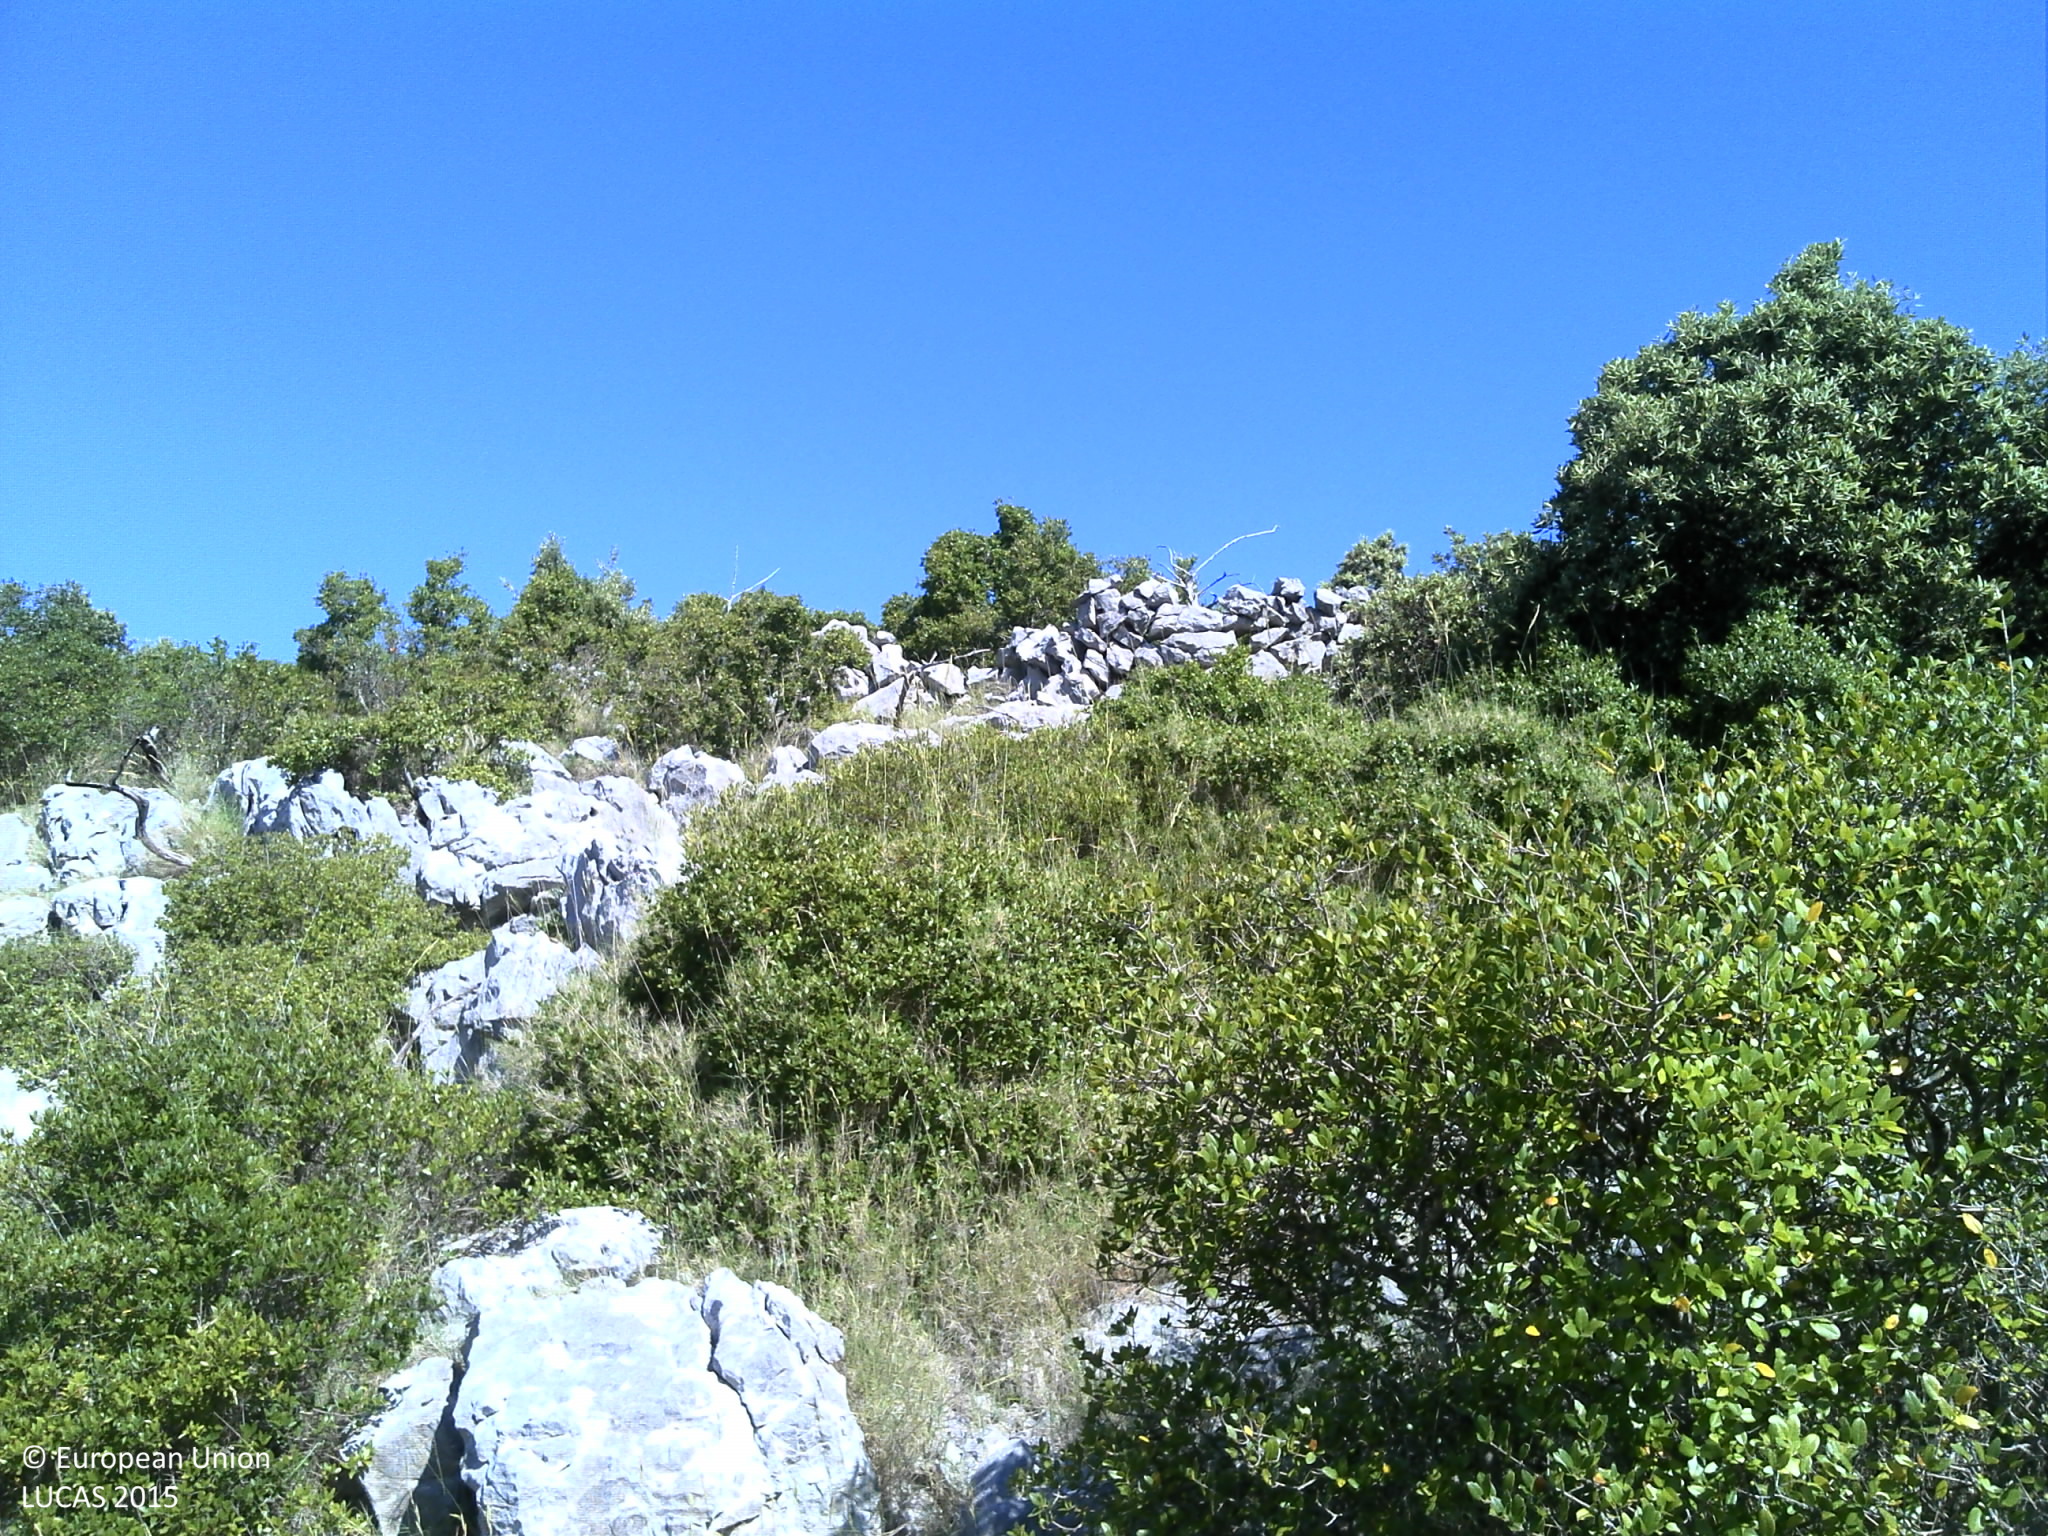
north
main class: Shrubland
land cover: Shrubland without tree cover
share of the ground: 25 - 50 %
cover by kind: shrubs 50 %, consolidated bare surface 20 %, unconsolidated bare surface 20 %, herbaceous plants 10 %
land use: Semi-natural and natural areas not in use
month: June
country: HR
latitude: 43.5205
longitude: 16.0896
